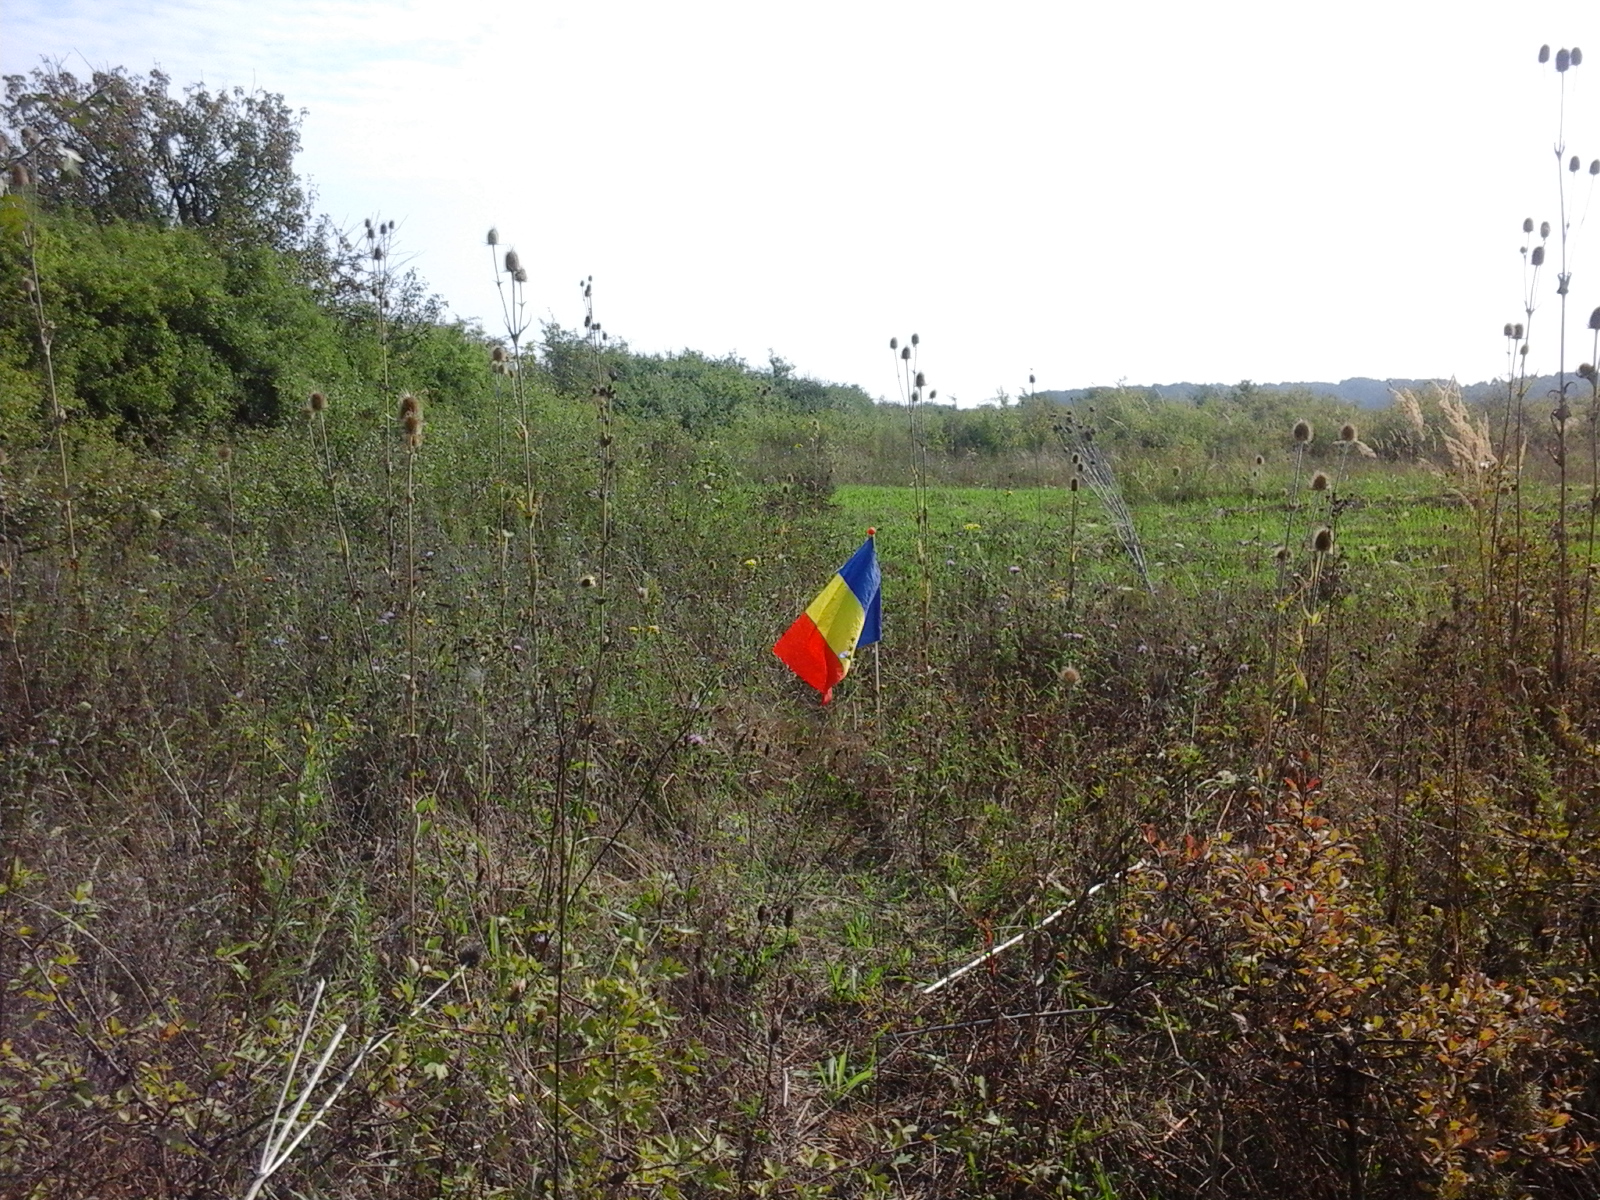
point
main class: Grassland
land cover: Spontaneously vegetated surfaces
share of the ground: > 75 %
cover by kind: herbaceous plants 100 %
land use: Agriculture (excluding fallow land and kitchen gardens)
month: August
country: RO
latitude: 46.6046
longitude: 21.8051
